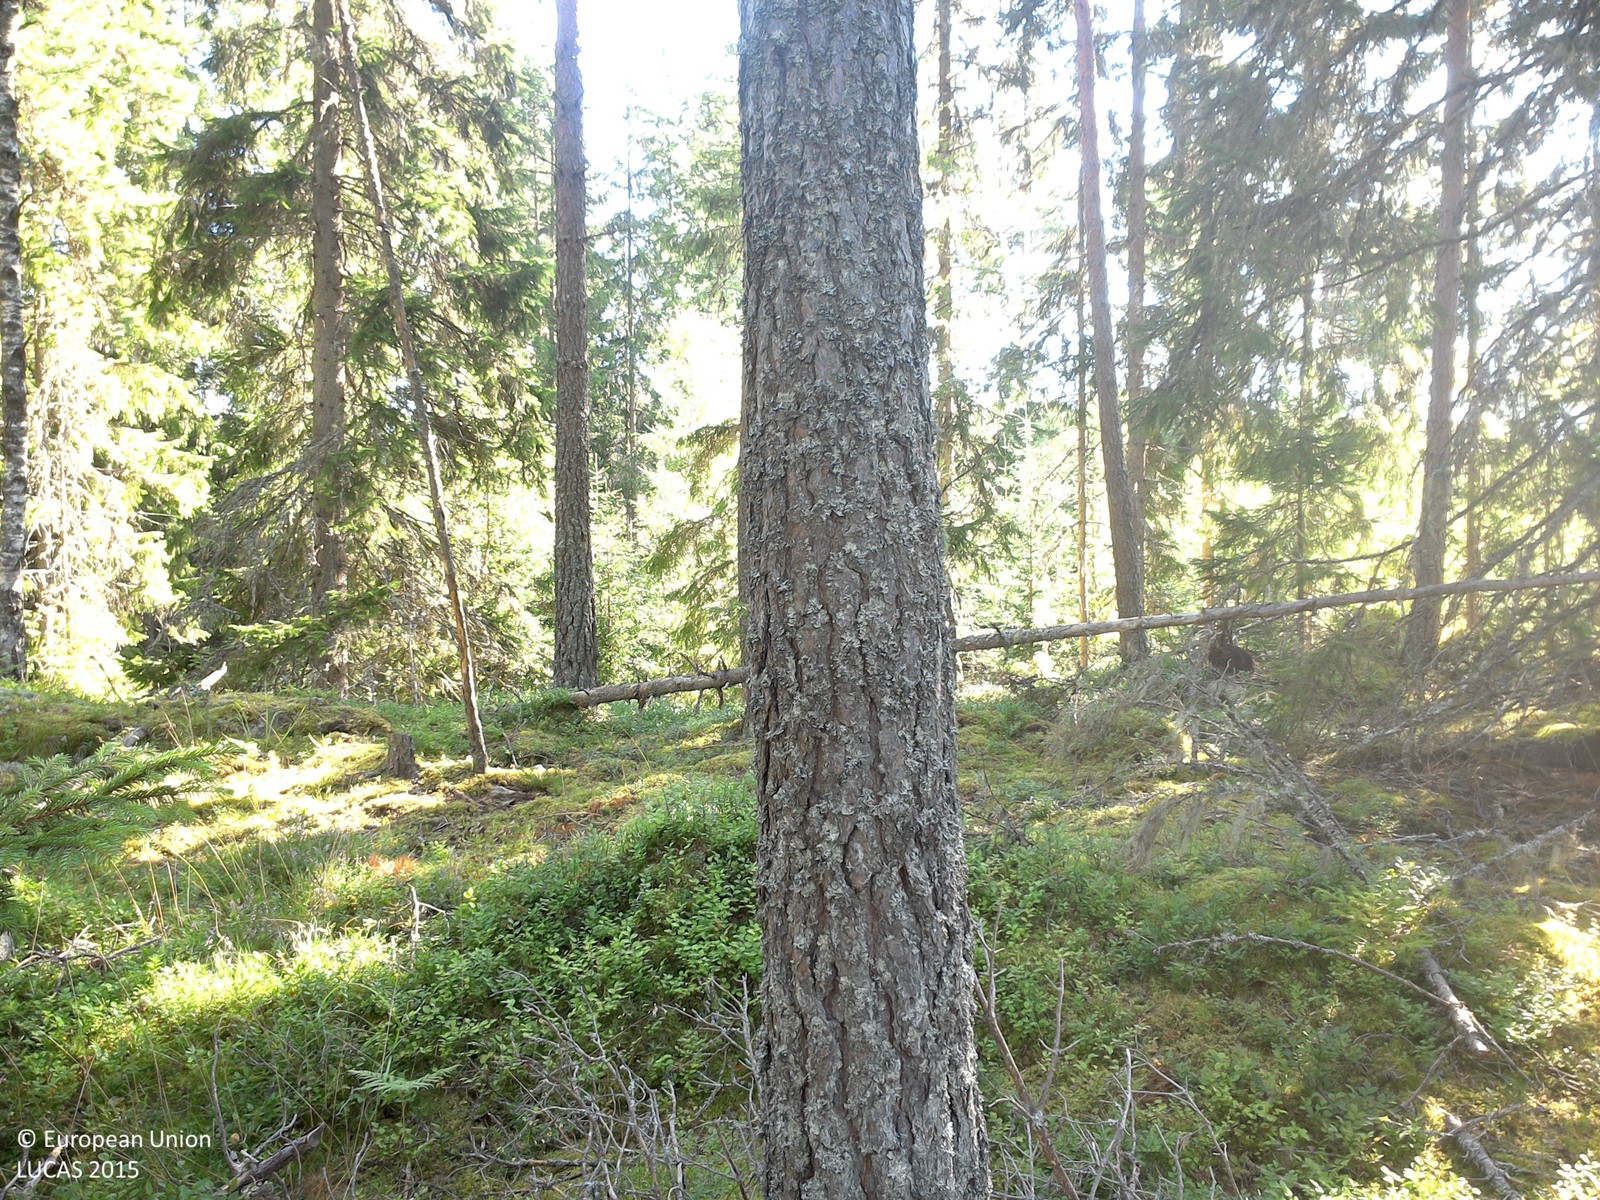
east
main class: Woodland
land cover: Pine dominated coniferous woodland
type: boreal forest
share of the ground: 25 - 50 %
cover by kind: coniferous forest trees 40 %, lichens and mosses 40 %, herbaceous plants 20 %
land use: Forestry
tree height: > 5 m
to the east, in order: Pine dominated coniferous woodland; Spruce dominated coniferous woodland; Spruce dominated mixed woodland; Broadleaved woodland; Pine dominated mixed woodland; Spruce dominated coniferous woodland
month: August
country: SE
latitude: 57.8804
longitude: 15.3074
